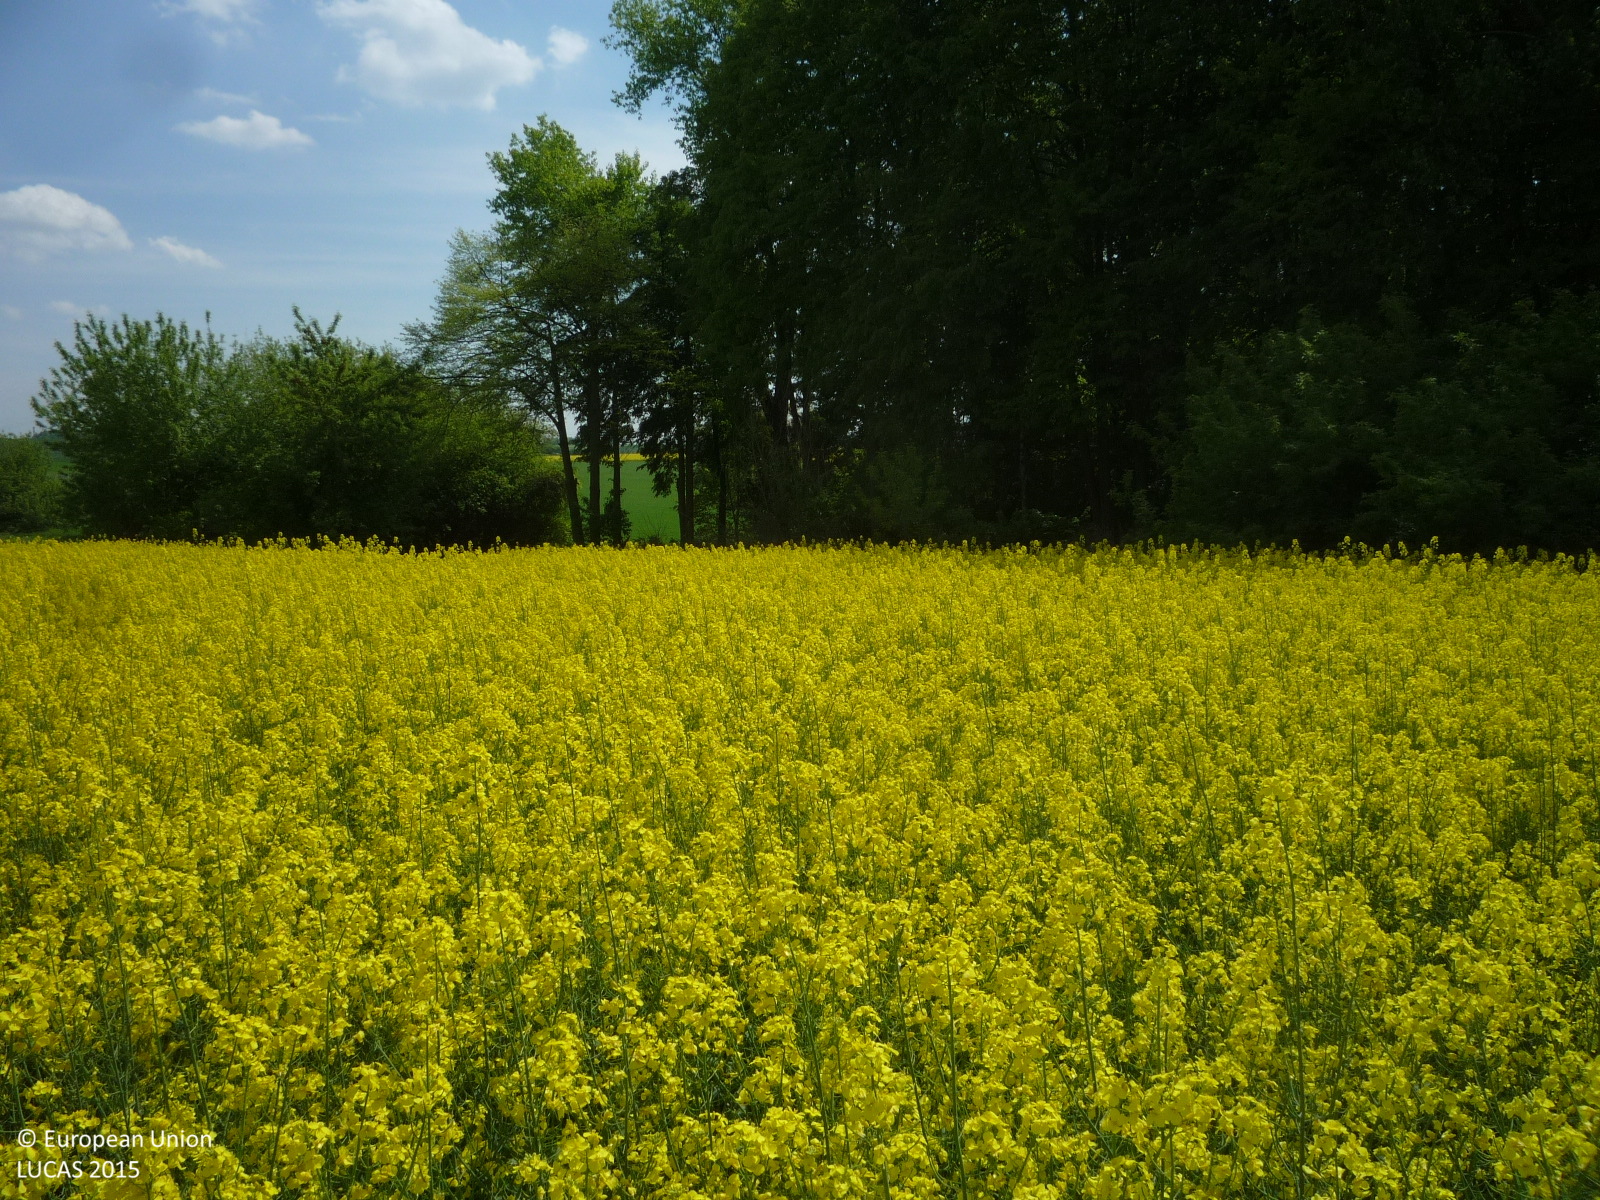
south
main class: Cropland
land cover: Rape and turnip rape
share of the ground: > 75 %
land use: Agriculture (excluding fallow land and kitchen gardens)
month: May
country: CZ
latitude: 50.1598
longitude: 14.6913
